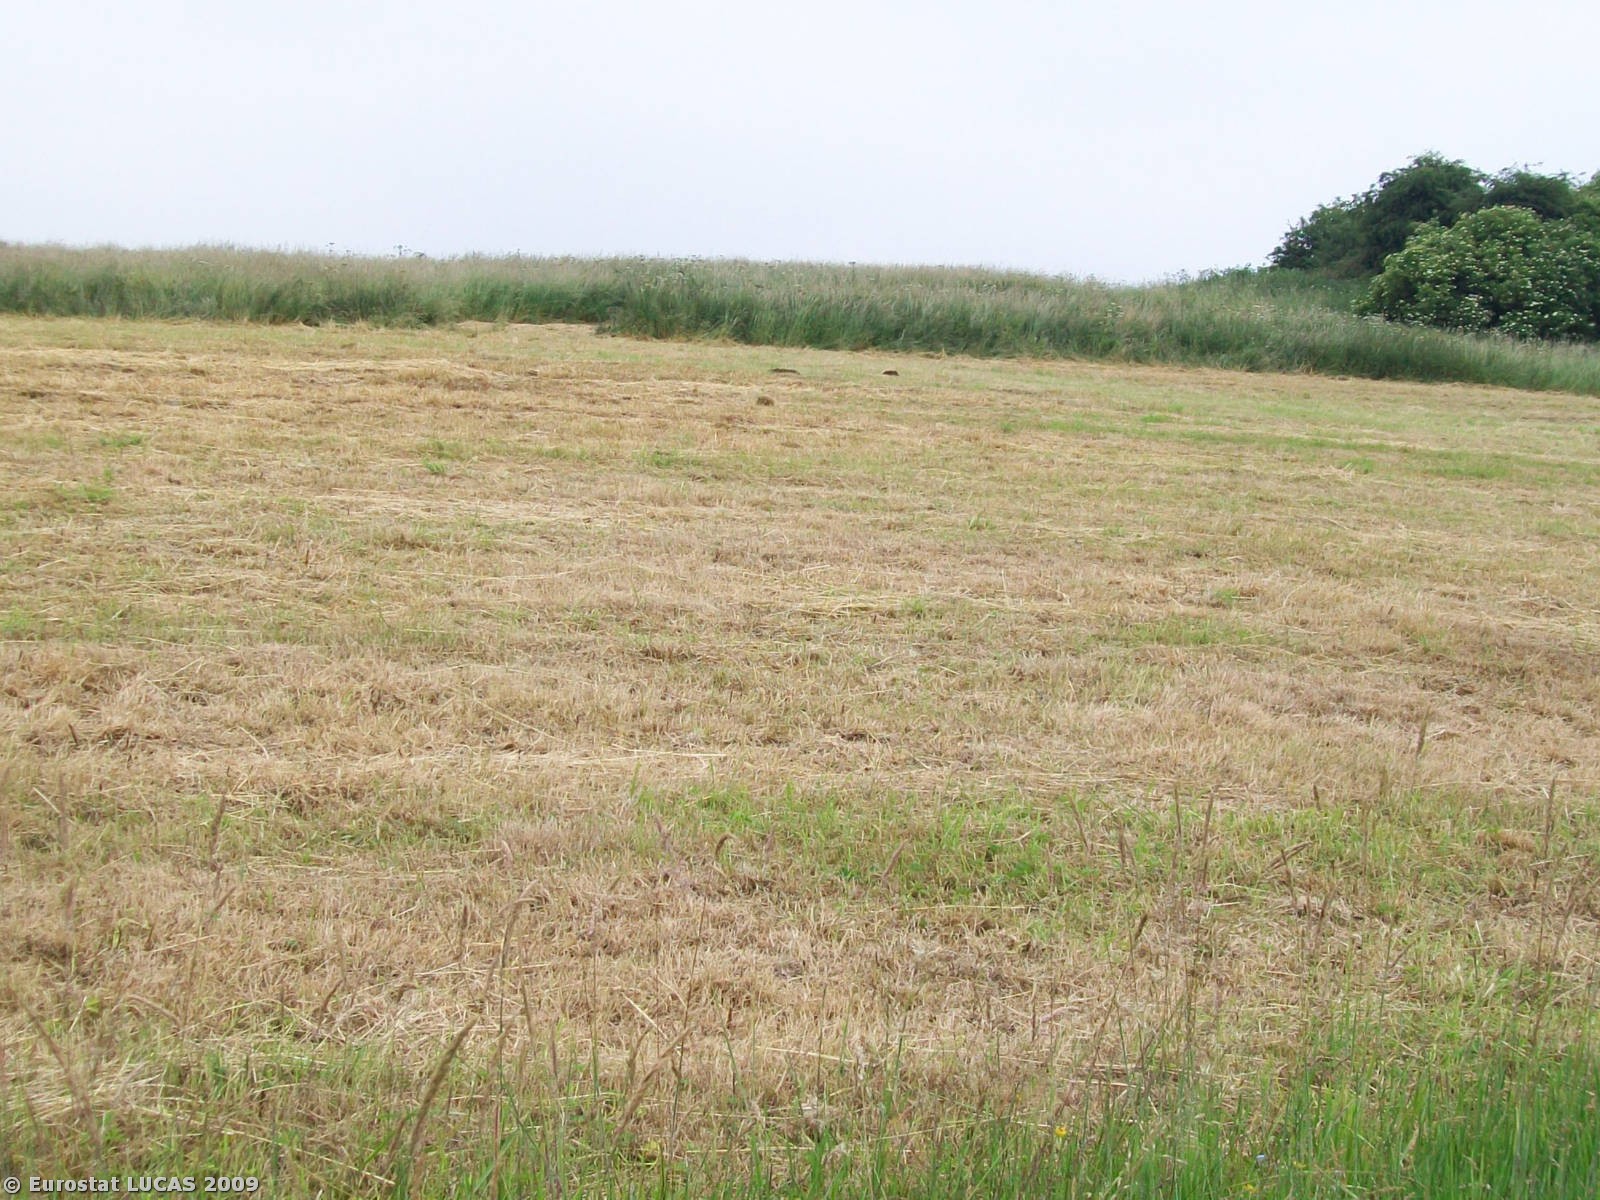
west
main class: Grassland
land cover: Grassland without tree/shrub cover
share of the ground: < 10 %
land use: Agriculture (excluding fallow land and kitchen gardens)
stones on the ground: < 10 %
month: July
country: GB
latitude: 53.8070
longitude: -1.3917
